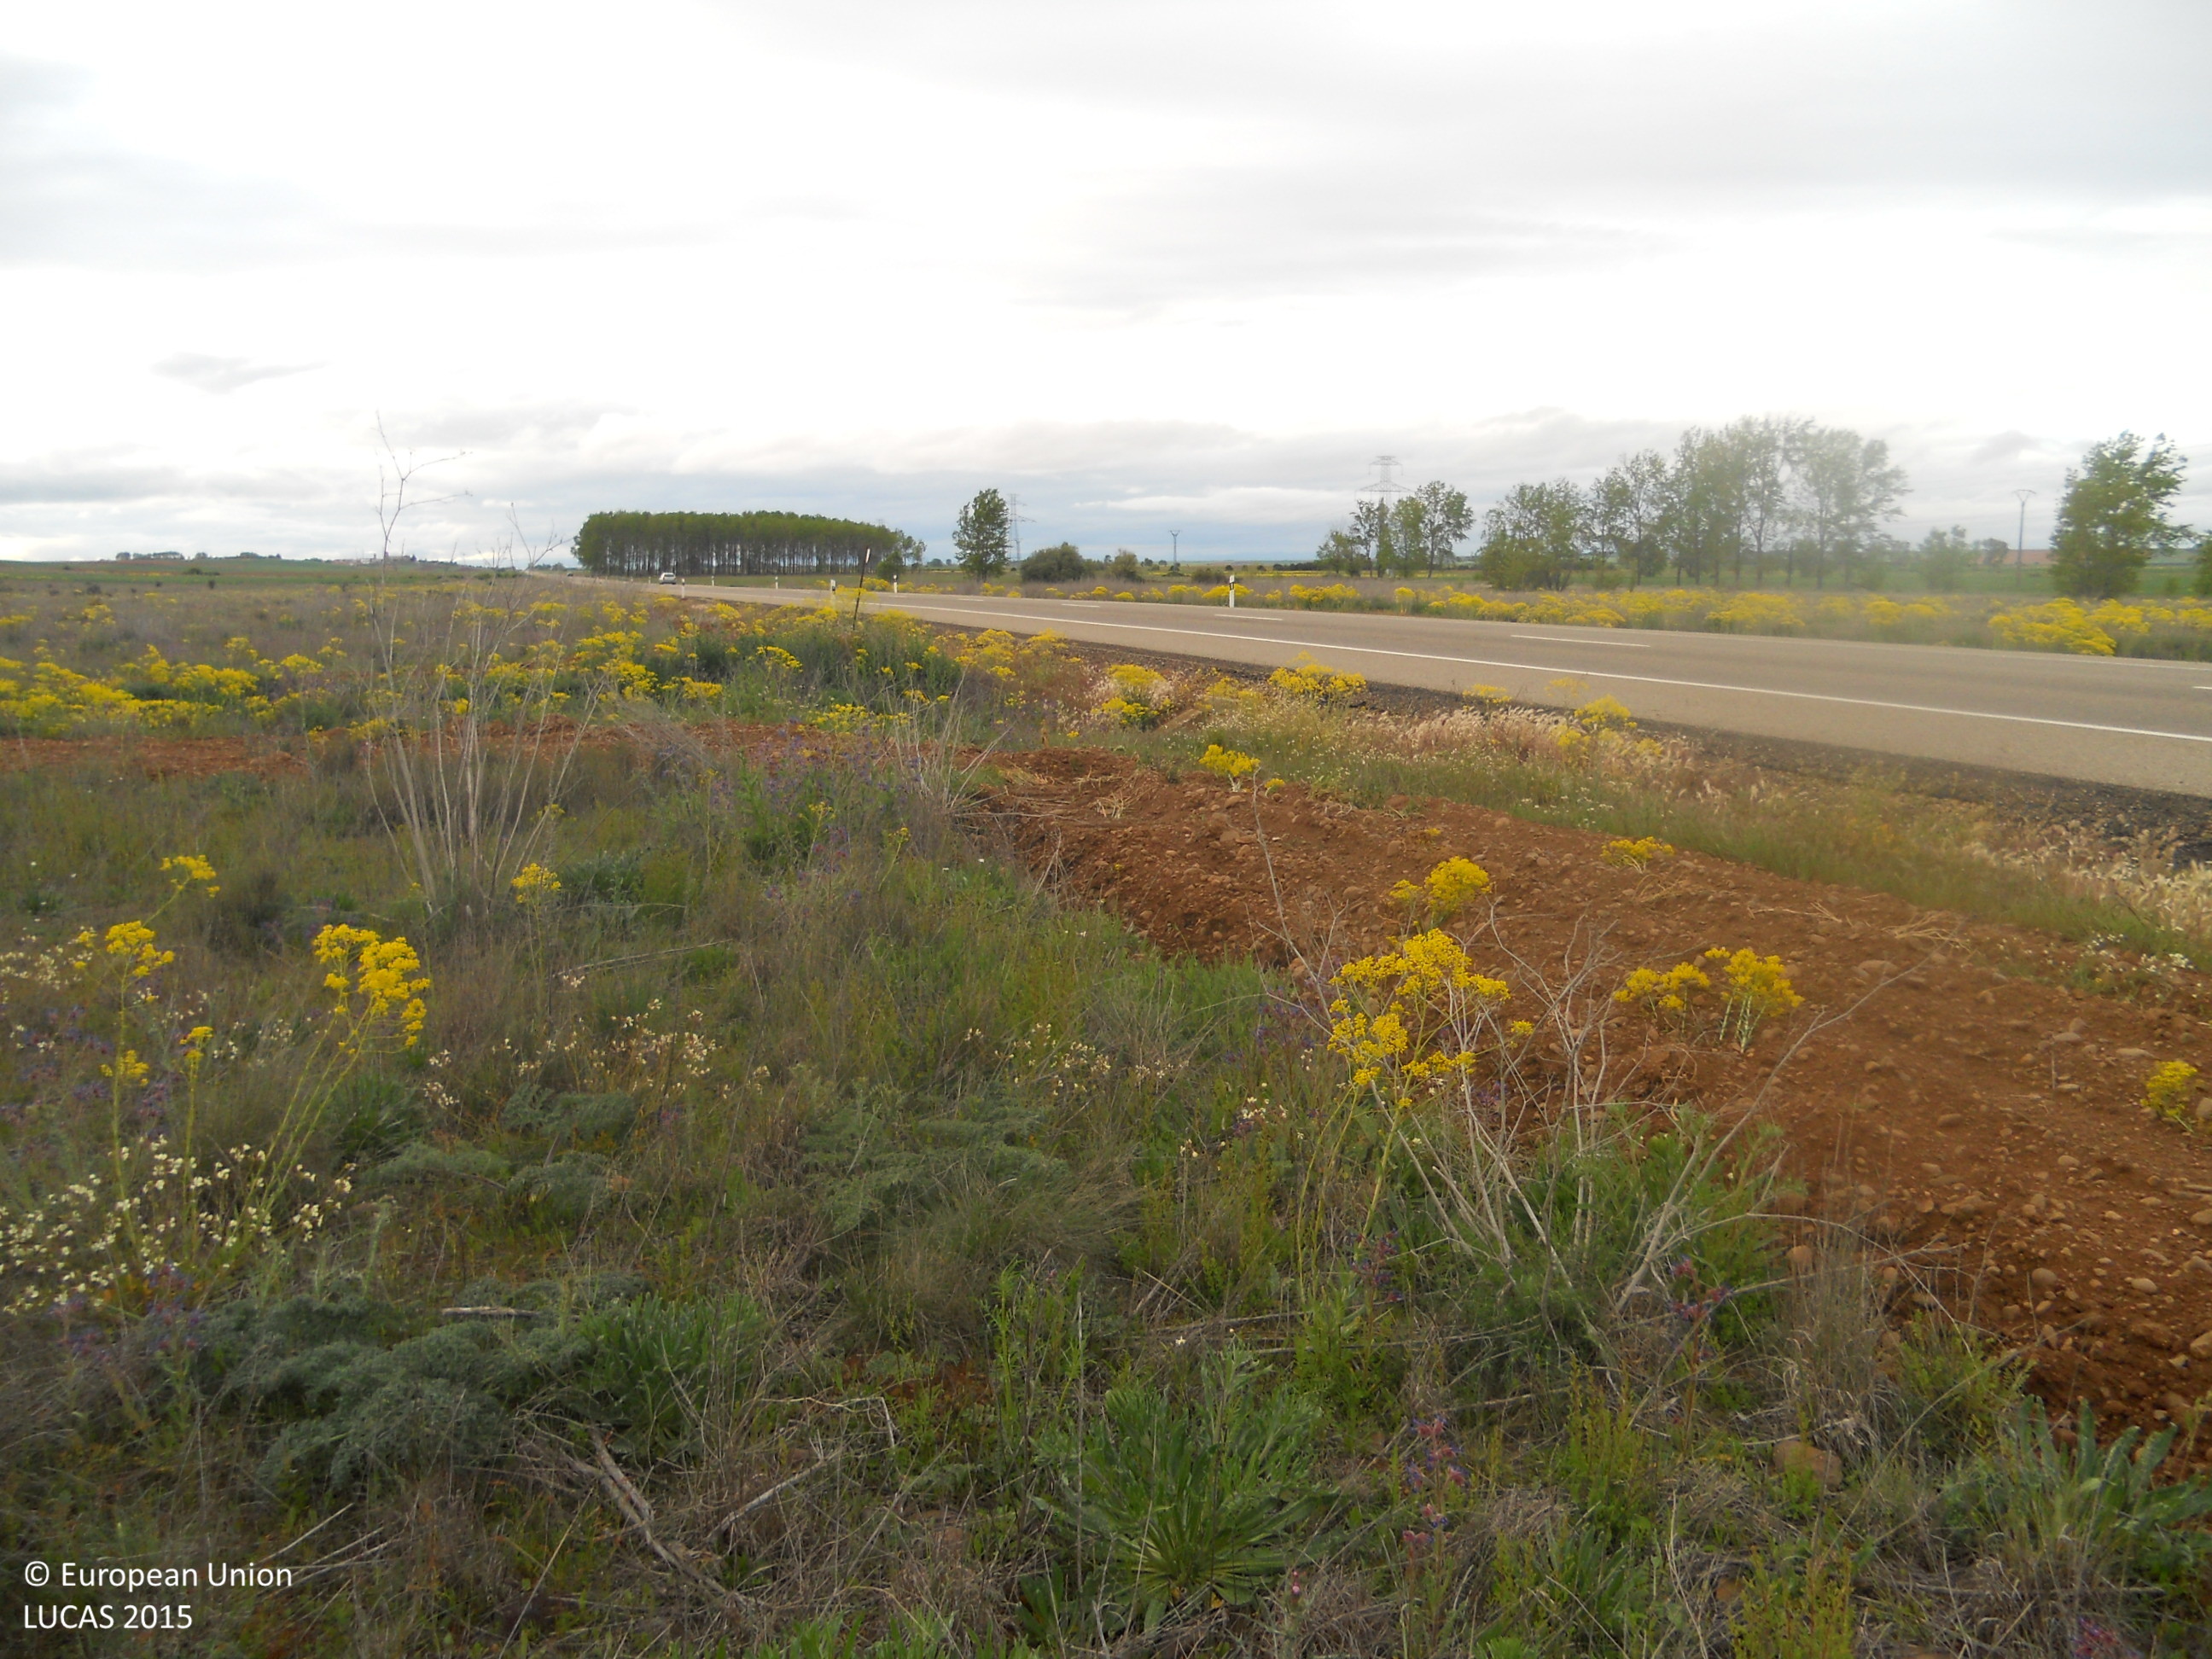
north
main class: Grassland
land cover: Spontaneously vegetated surfaces
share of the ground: > 75 %
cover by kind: herbaceous plants 80 %, unconsolidated bare surface 20 %
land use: Fallow land
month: May
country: ES
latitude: 42.2756
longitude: -5.2802
